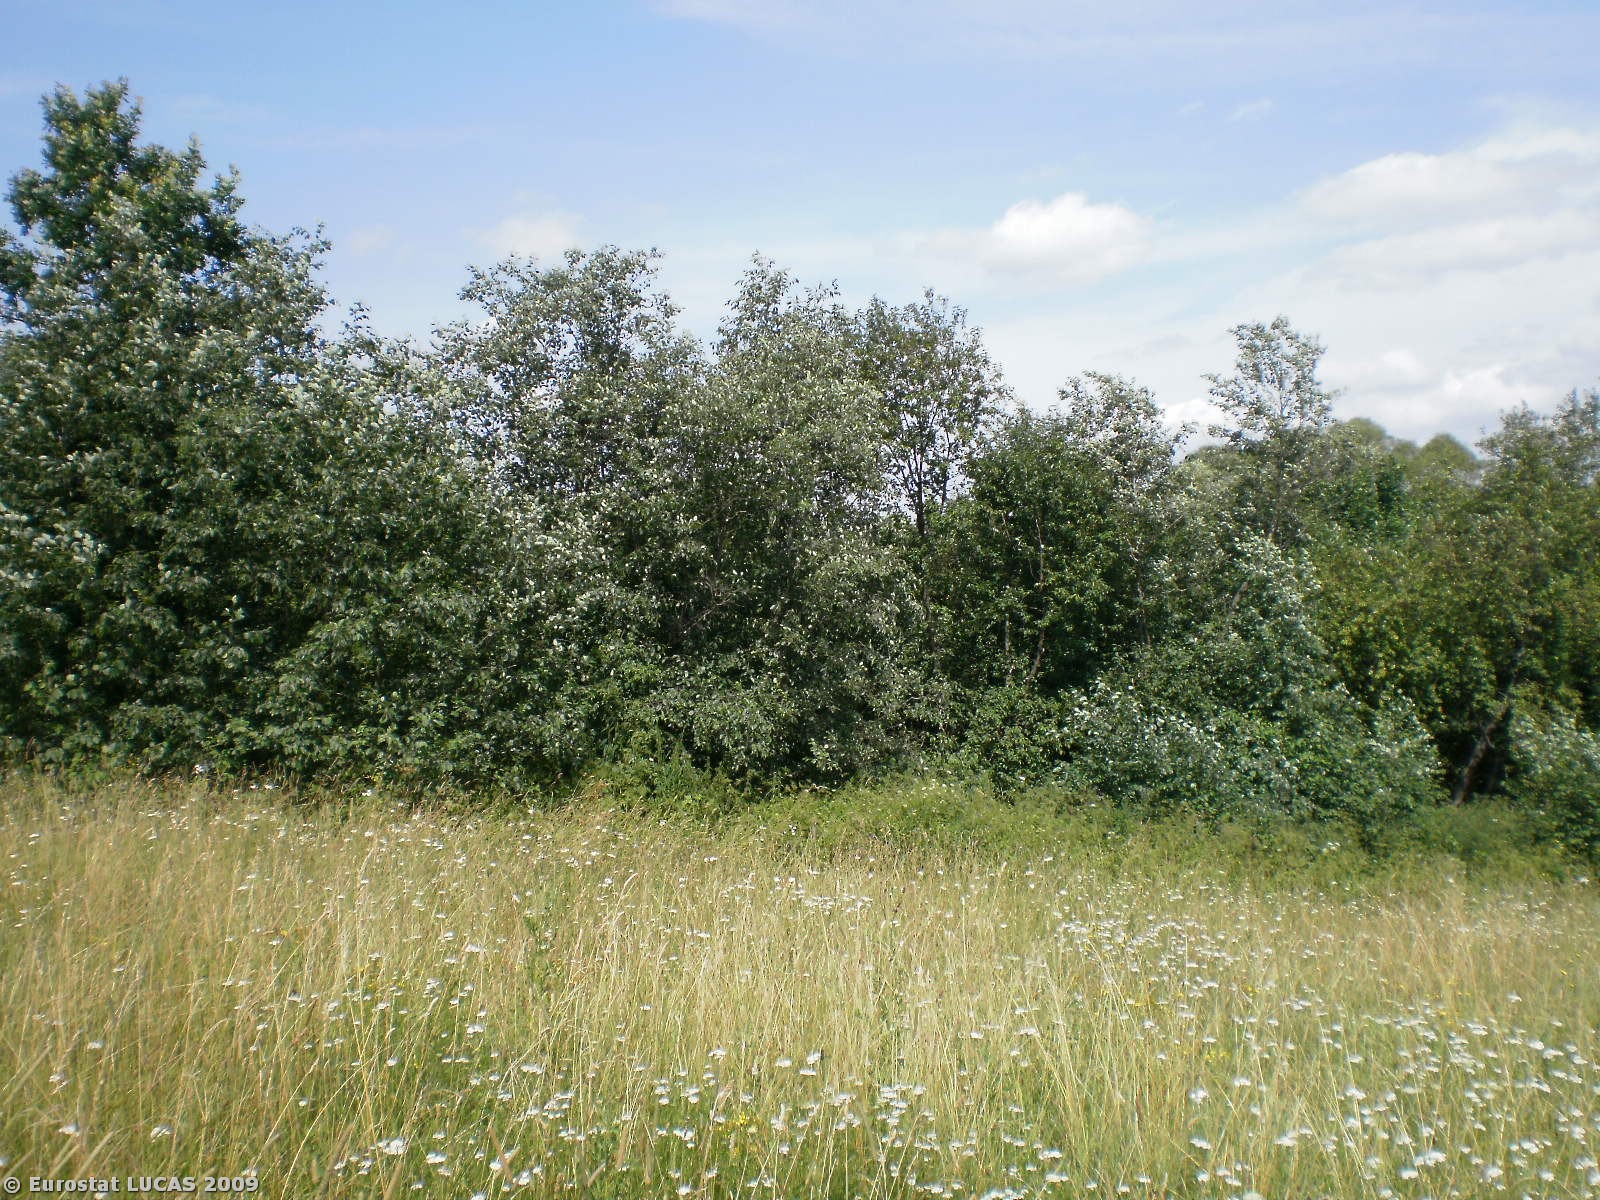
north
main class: Grassland
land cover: Grassland without tree/shrub cover
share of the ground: > 75 %
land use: Agriculture (excluding fallow land and kitchen gardens)
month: July
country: PL
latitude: 54.1317
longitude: 19.9627
